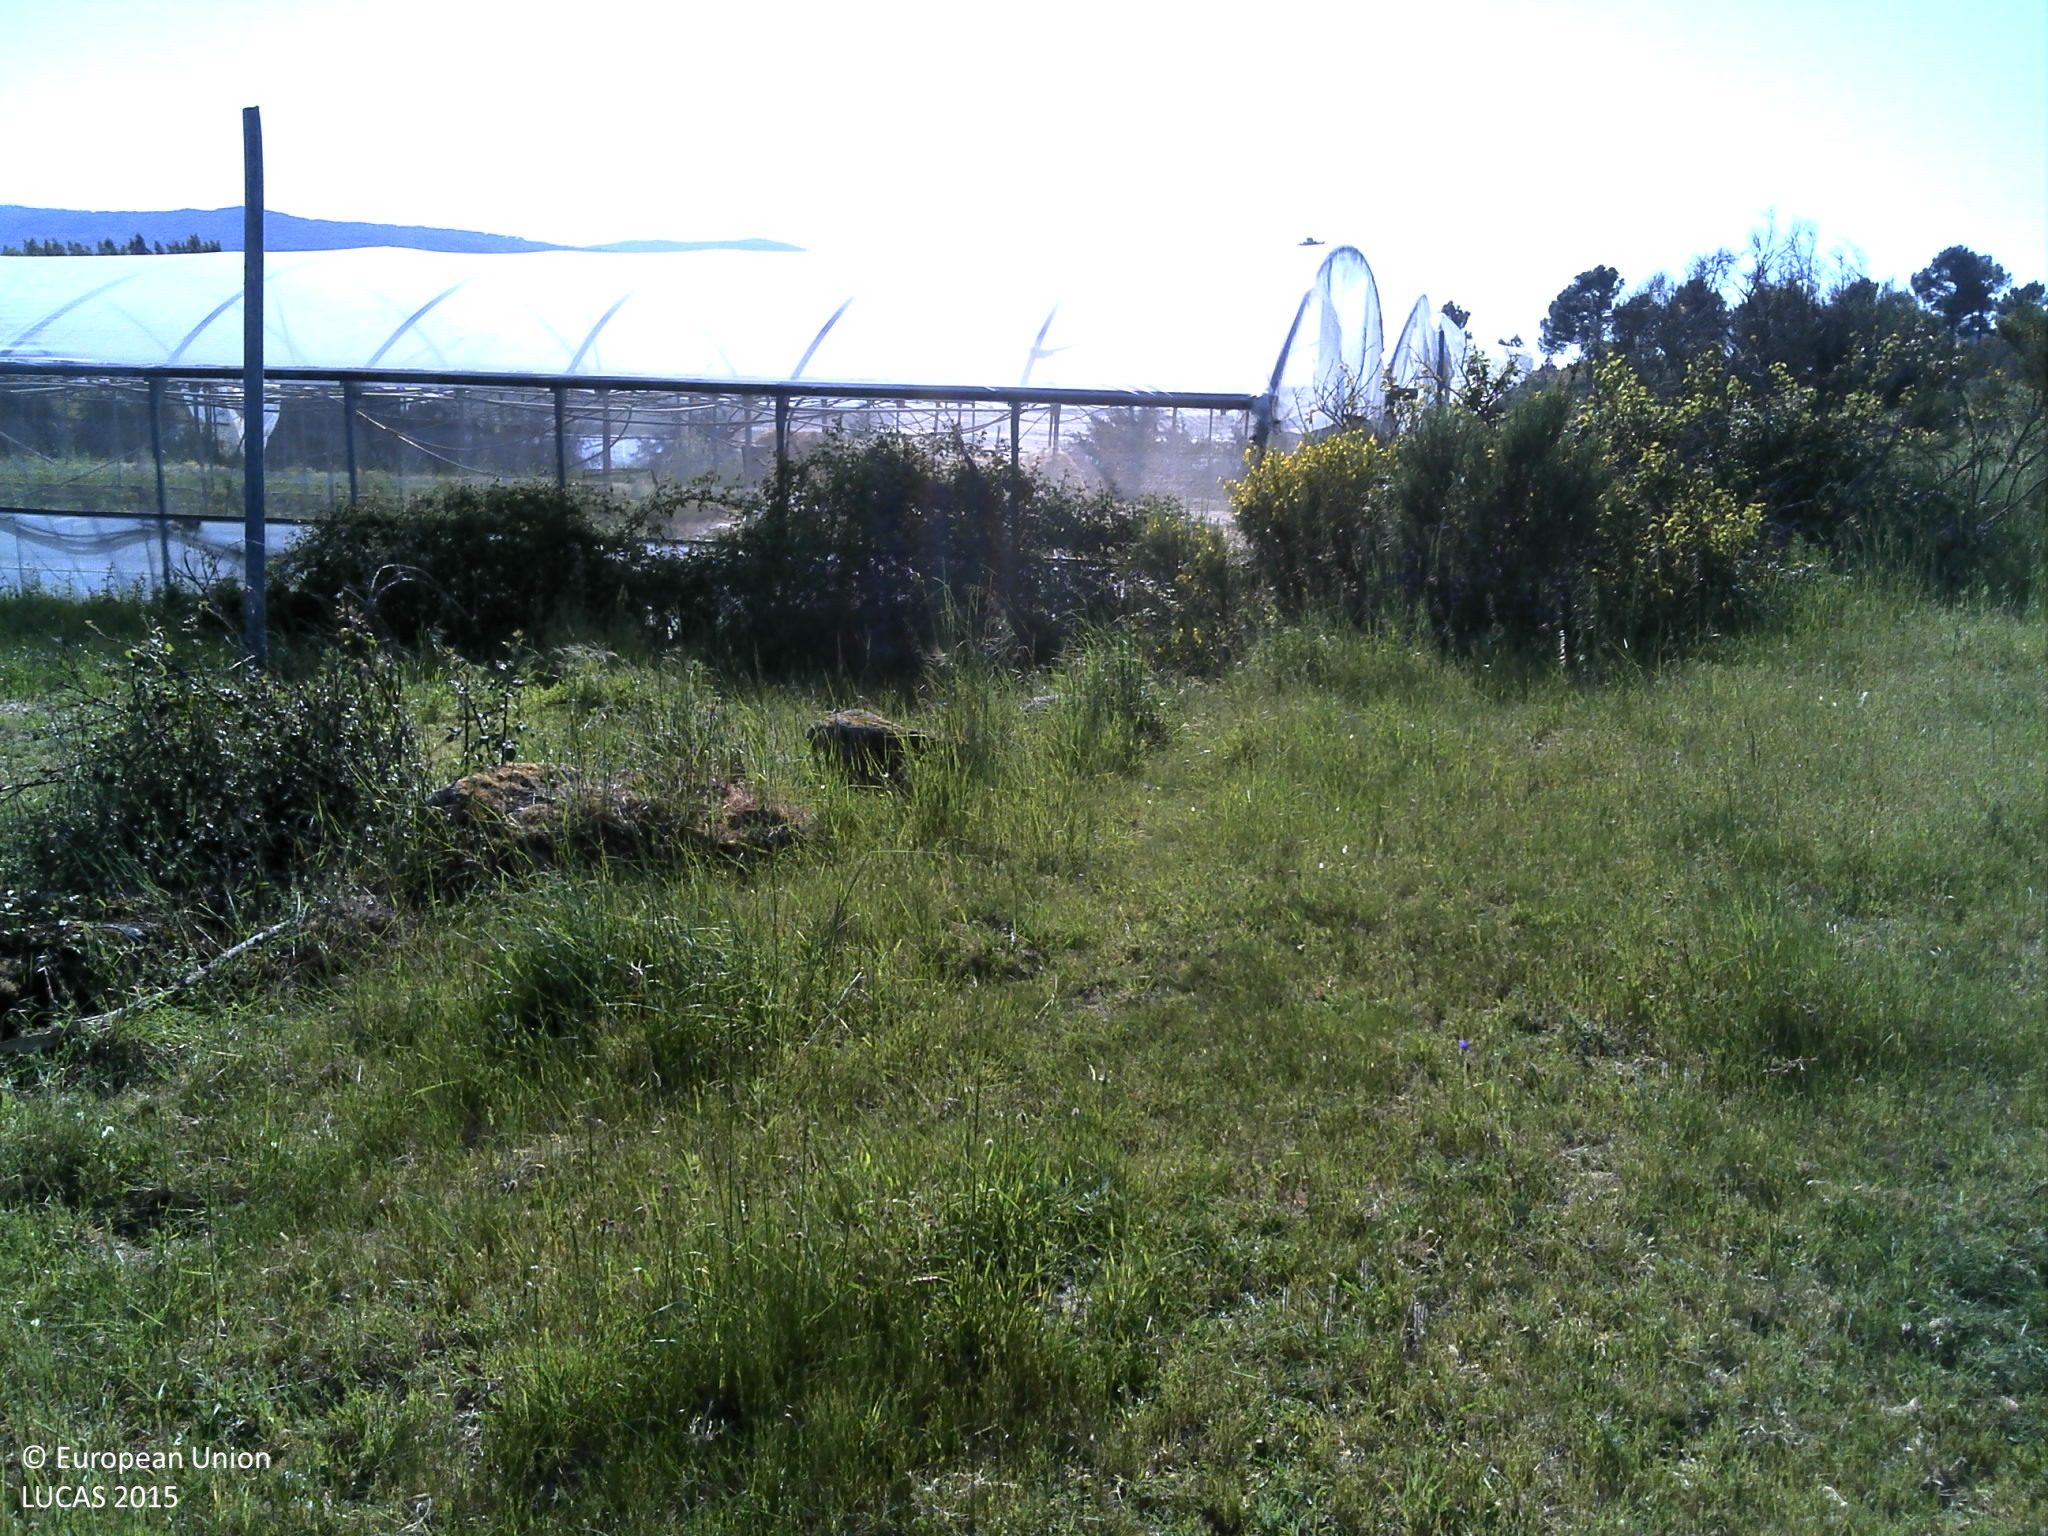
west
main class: Grassland
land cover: Grassland without tree/shrub cover
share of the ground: > 75 %
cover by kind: herbaceous plants 80 %, unconsolidated bare surface 15 %, shrubs 5 %
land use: Agriculture (excluding fallow land and kitchen gardens)
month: May
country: PT
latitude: 41.5636
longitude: -7.5775
